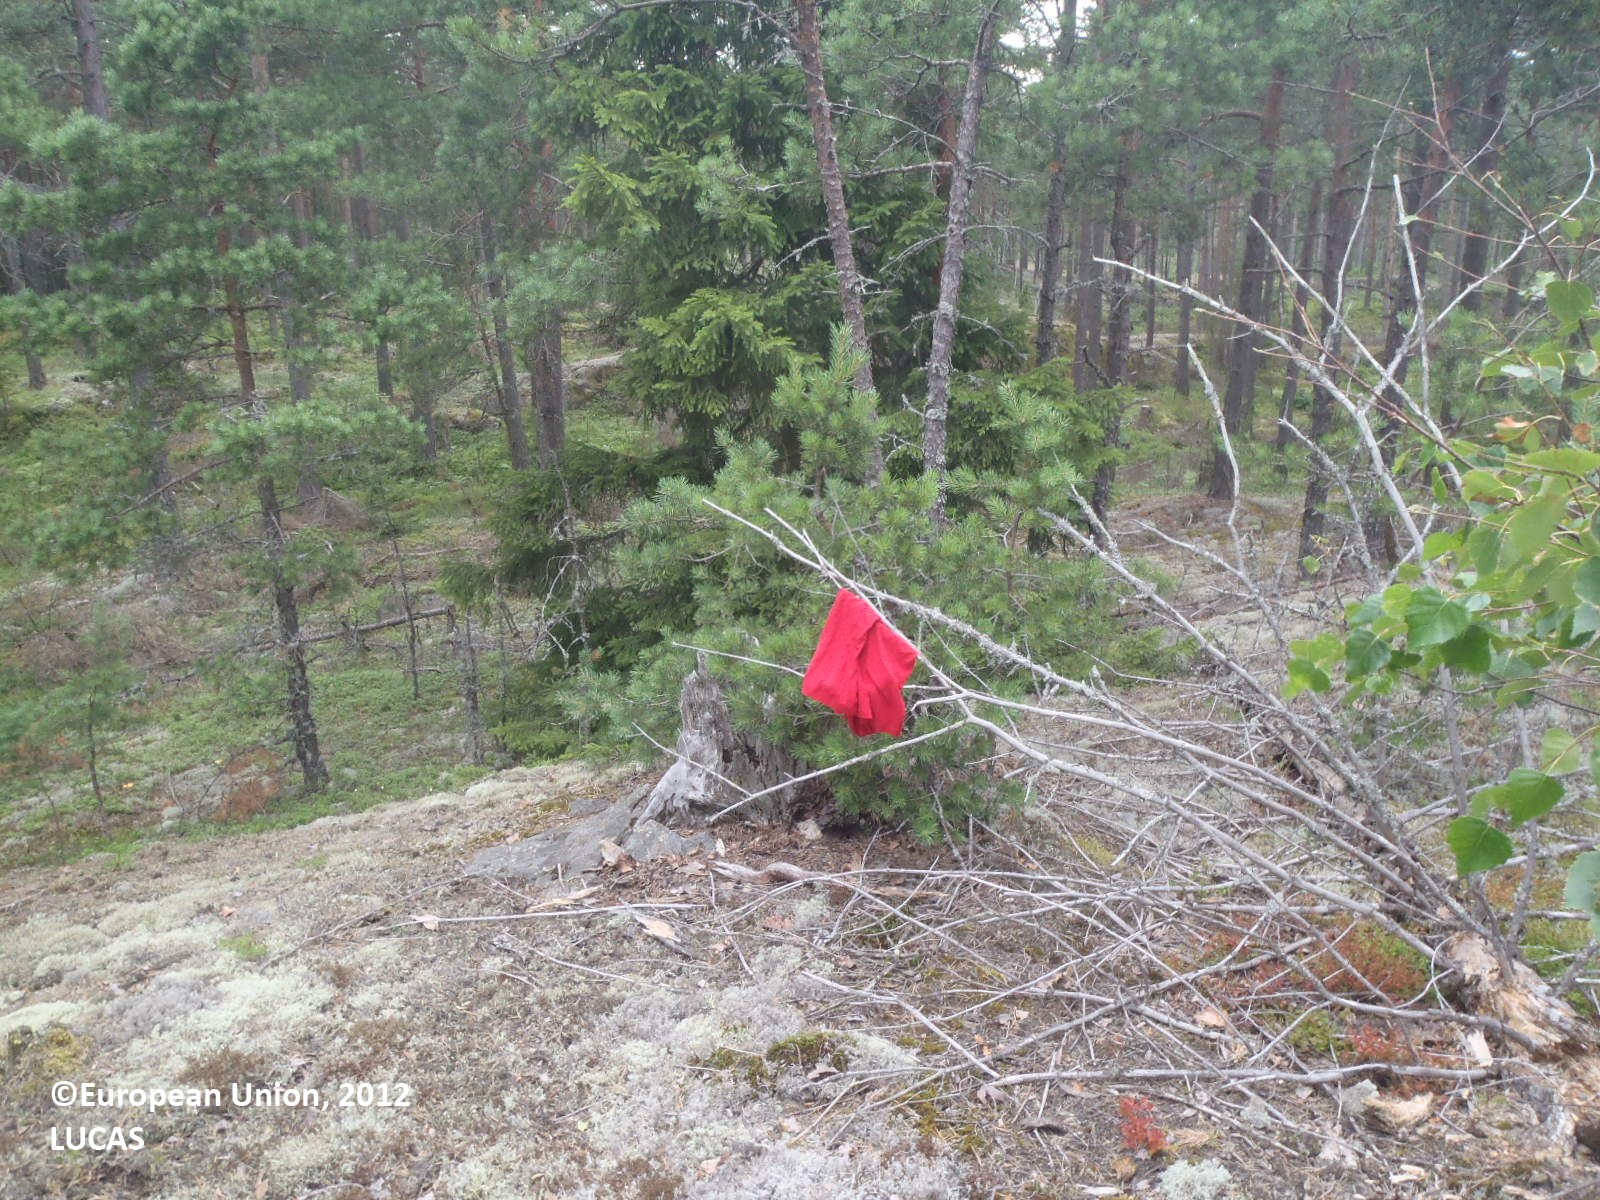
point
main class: Woodland
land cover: Pine dominated coniferous woodland
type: boreal forest
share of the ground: 25 - 50 %
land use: Forestry
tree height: > 5 m
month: July
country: FI
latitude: 60.3232
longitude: 21.9967
